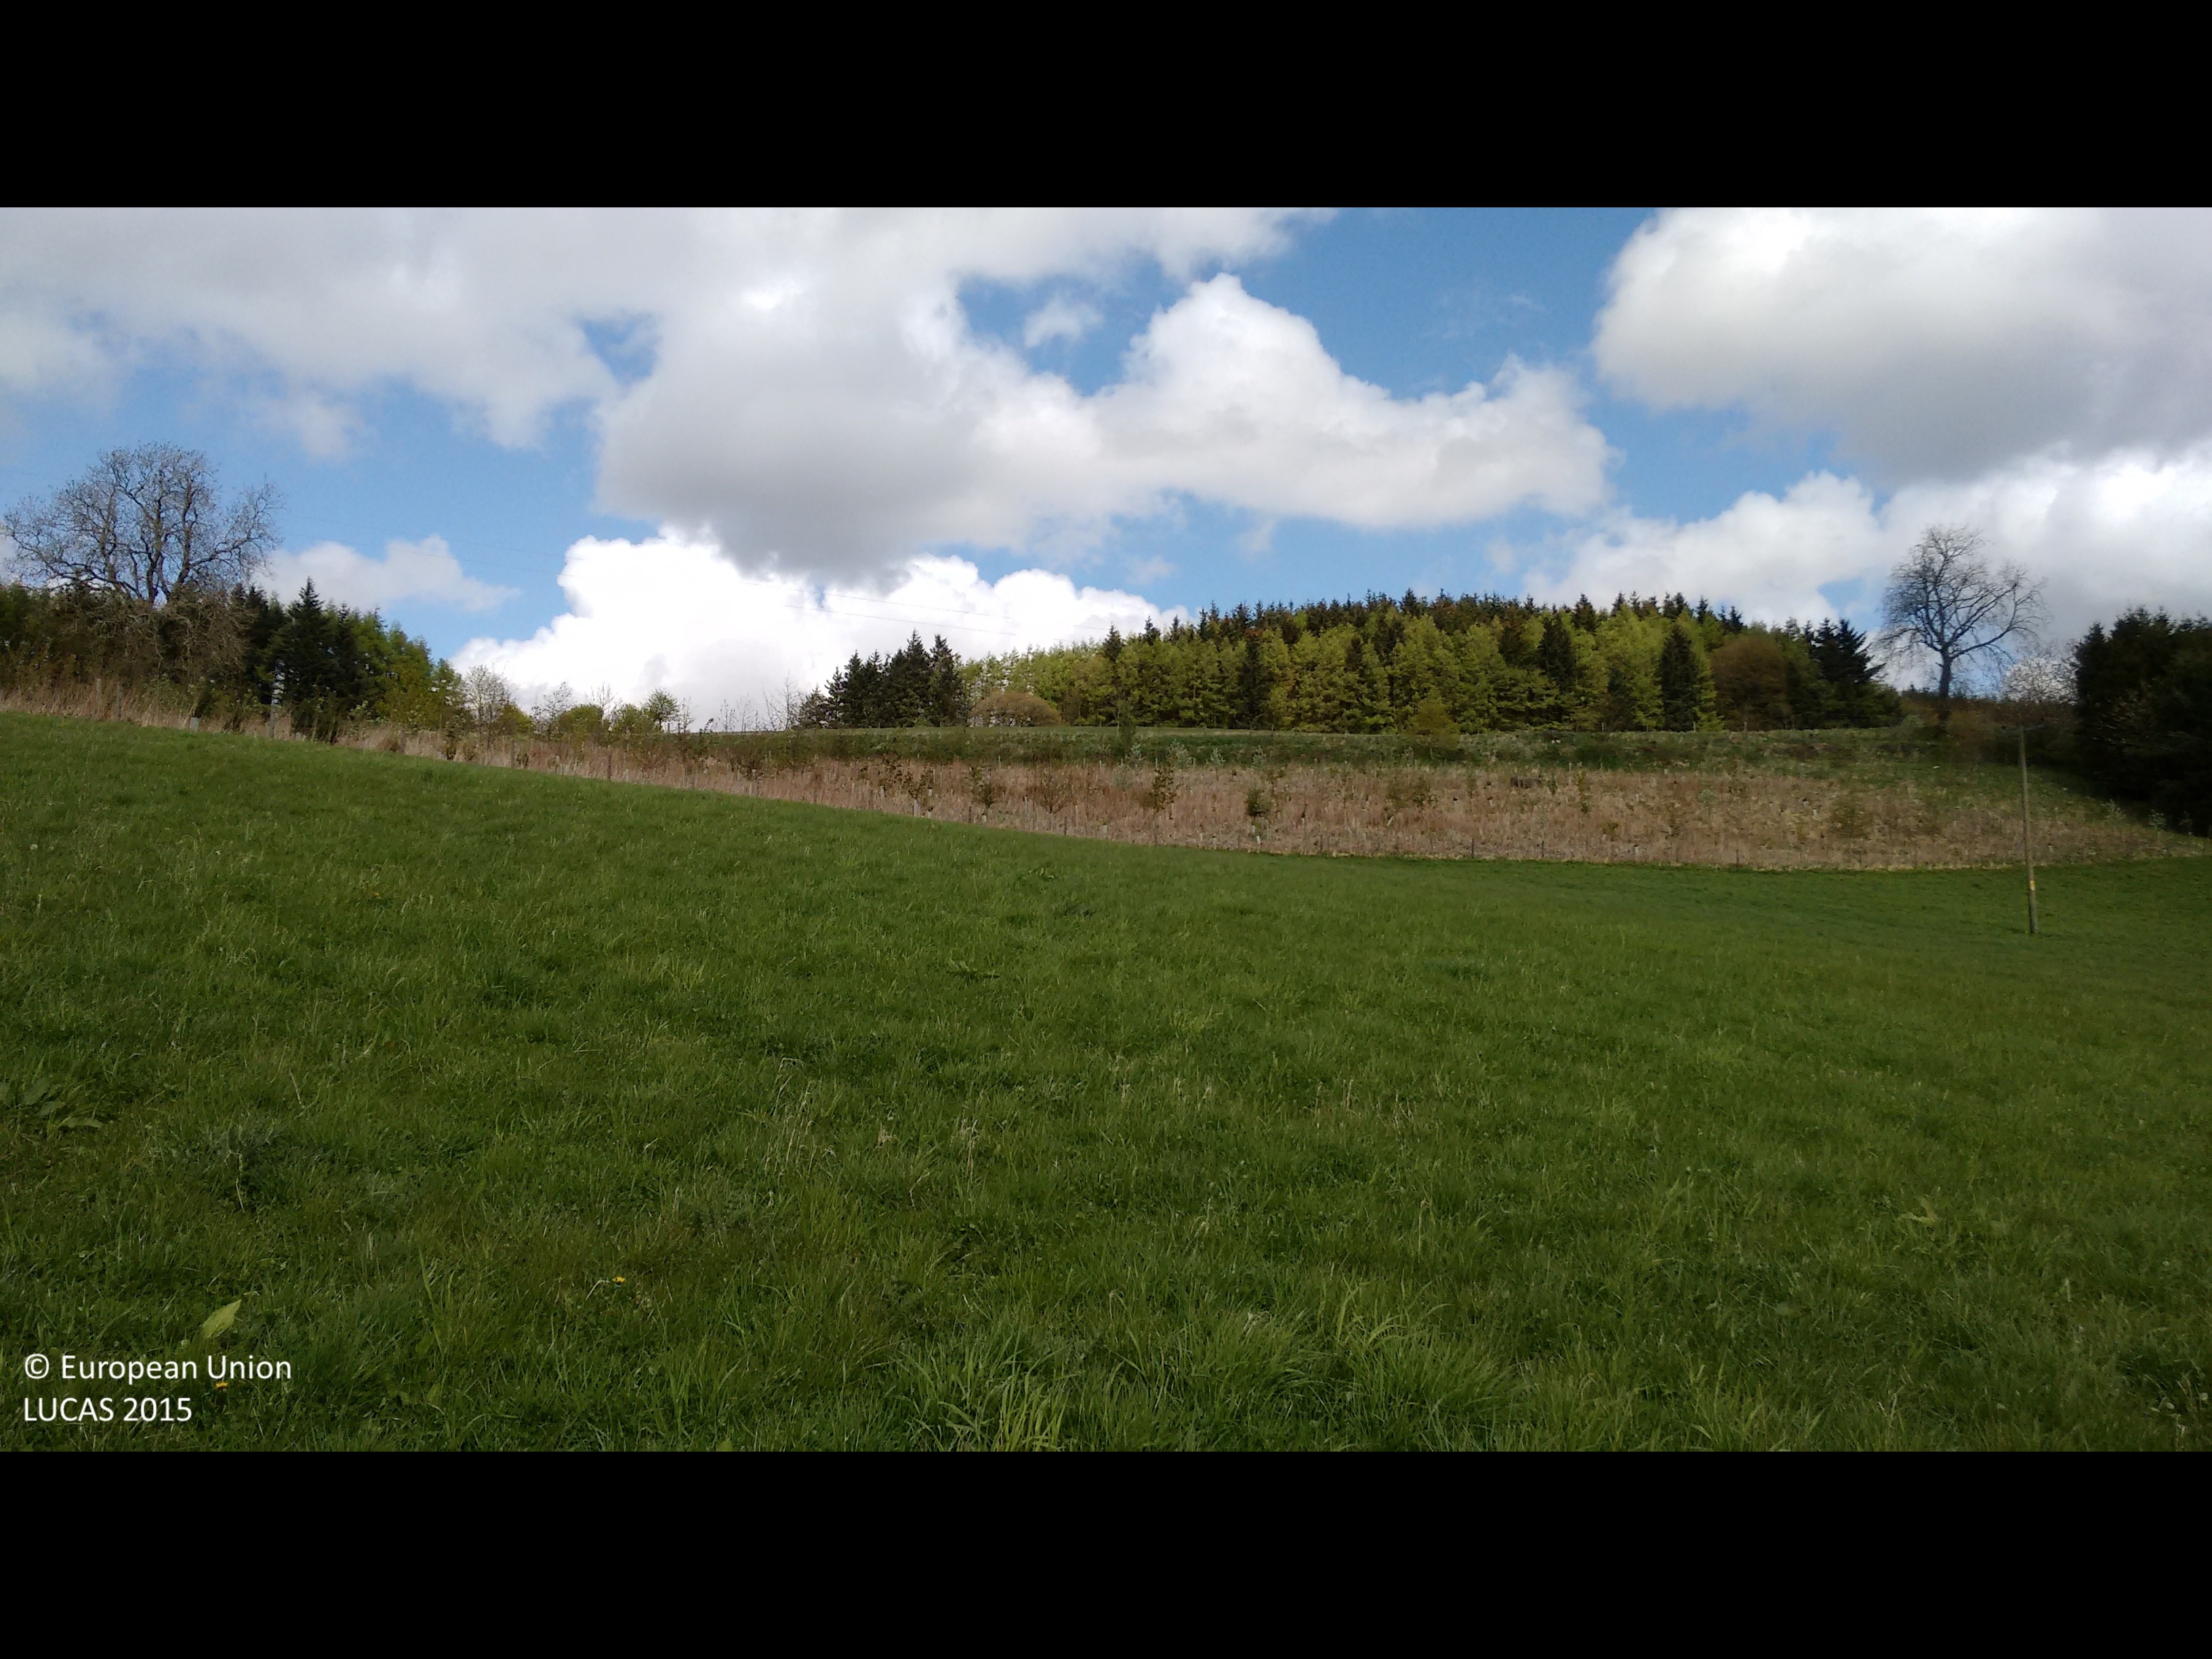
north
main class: Grassland
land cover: Grassland without tree/shrub cover
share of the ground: > 75 %
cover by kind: herbaceous plants 100 %
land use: Agriculture (excluding fallow land and kitchen gardens)
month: May
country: GB
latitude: 56.5284
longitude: -3.1558
